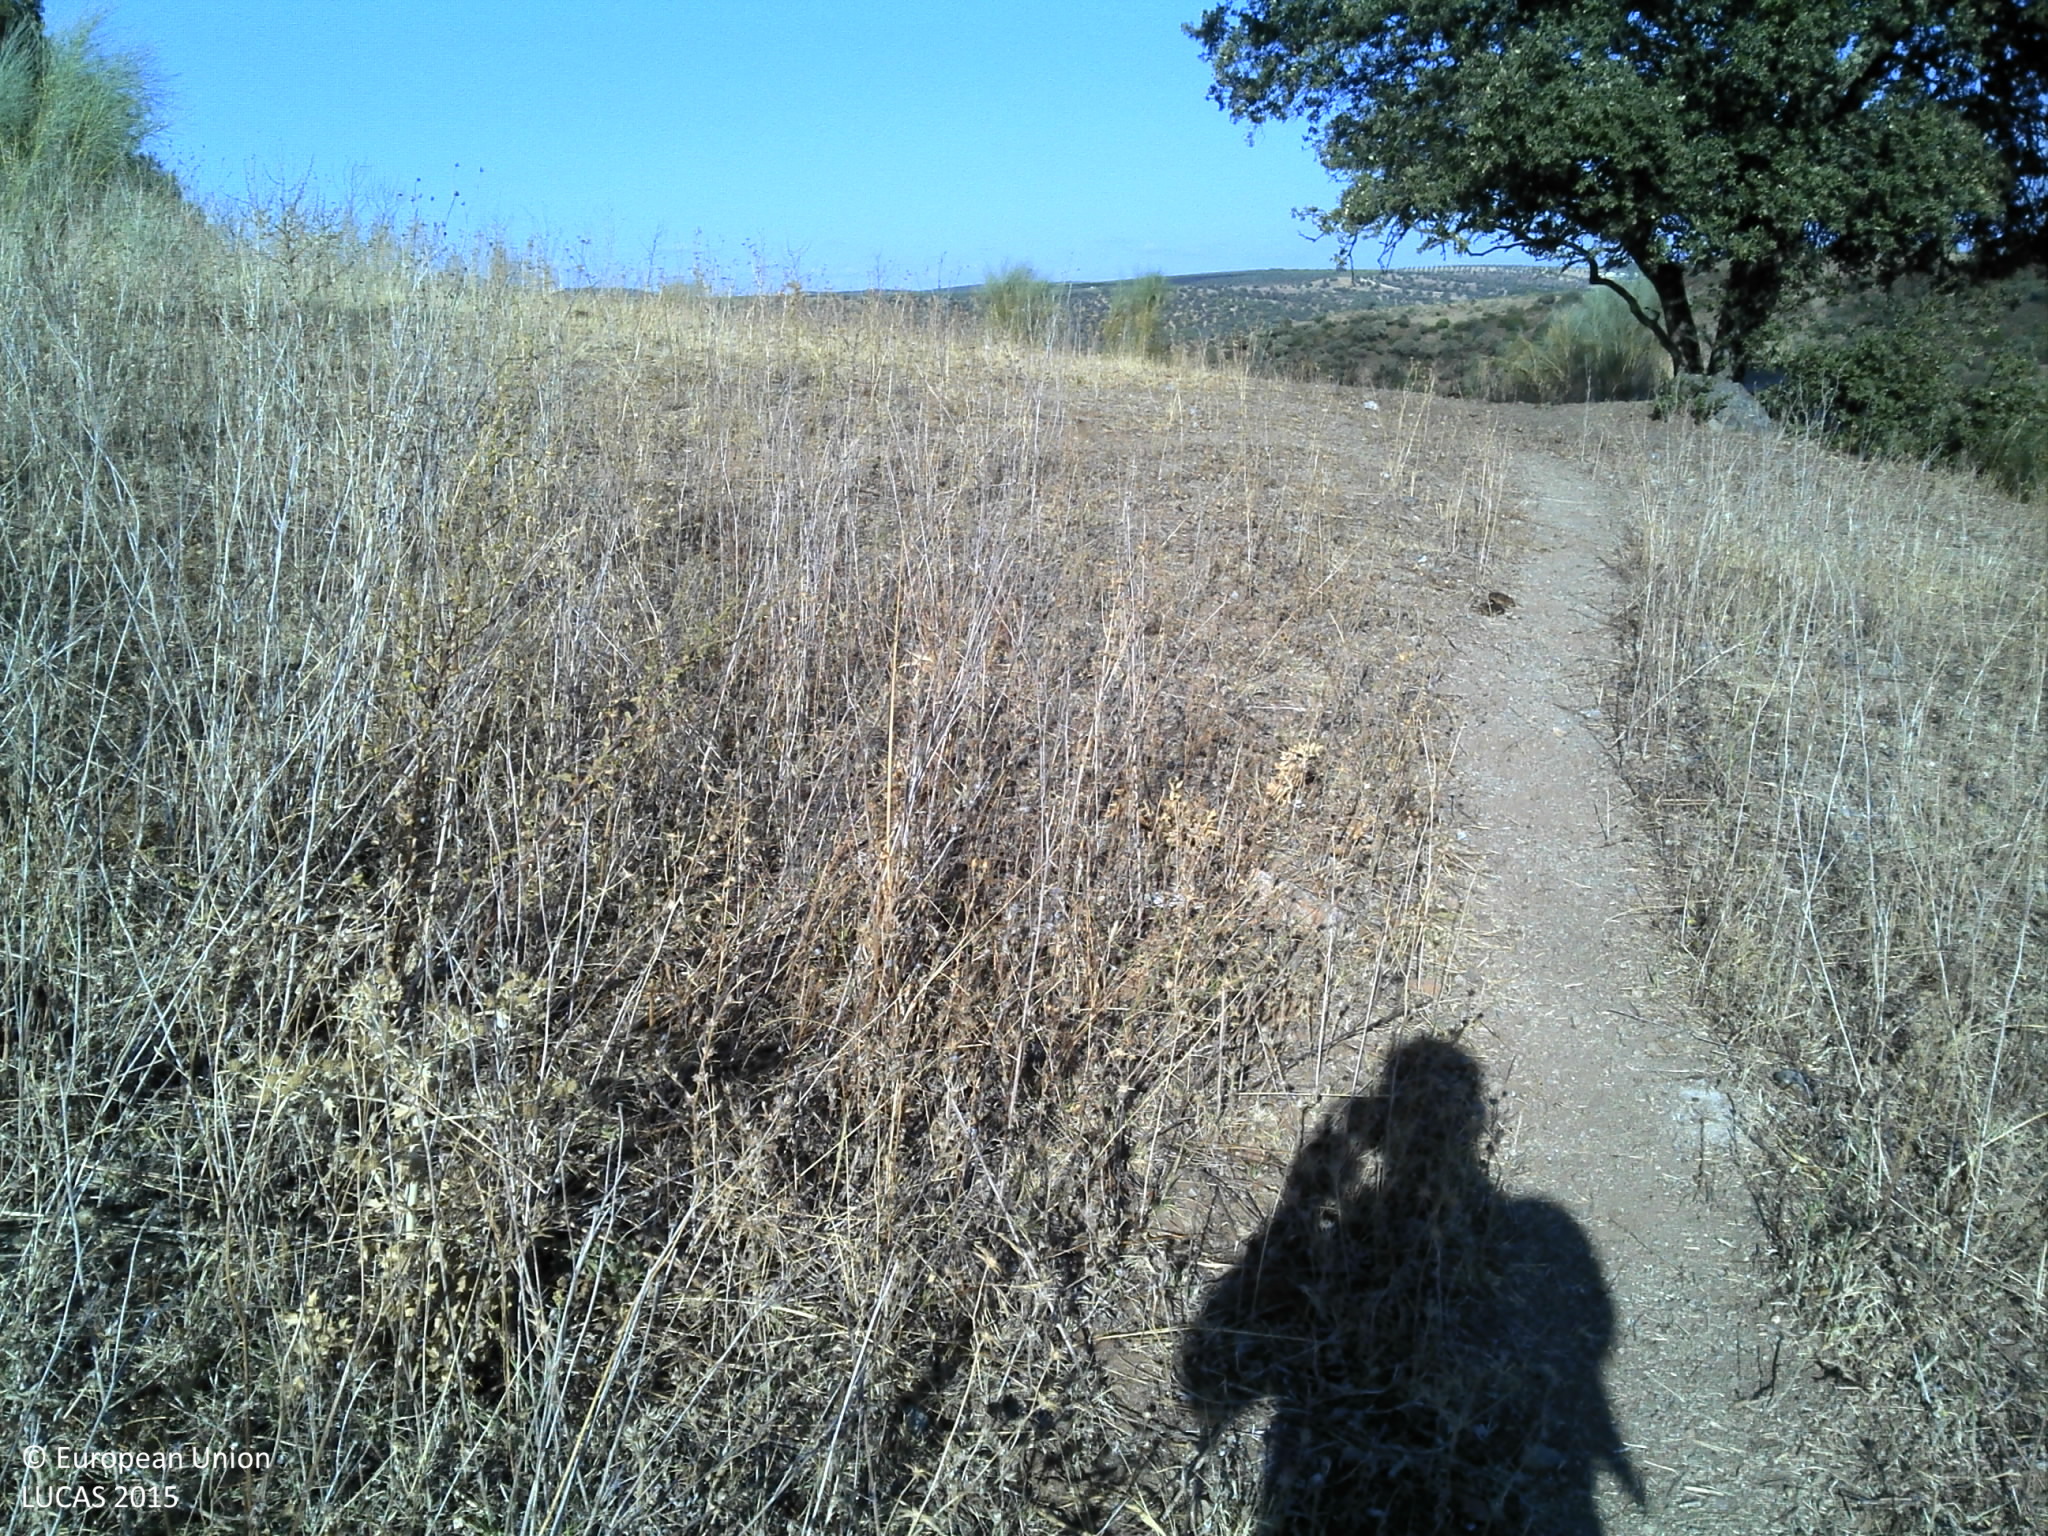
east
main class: Grassland
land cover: Grassland with sparse tree/shrub cover
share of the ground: 25 - 50 %
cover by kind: herbaceous plants 90 %, broadleaved forest trees 5 %, unconsolidated bare surface 5 %
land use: Agriculture (excluding fallow land and kitchen gardens)
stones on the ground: < 10 %
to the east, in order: Grassland with sparse tree/shrub cover; Grassland without tree/shrub cover; Tracks; Grassland with sparse tree/shrub cover; Rivers and streams; Grassland with sparse tree/shrub cover
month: July
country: PT
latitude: 37.9113
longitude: -7.6625
